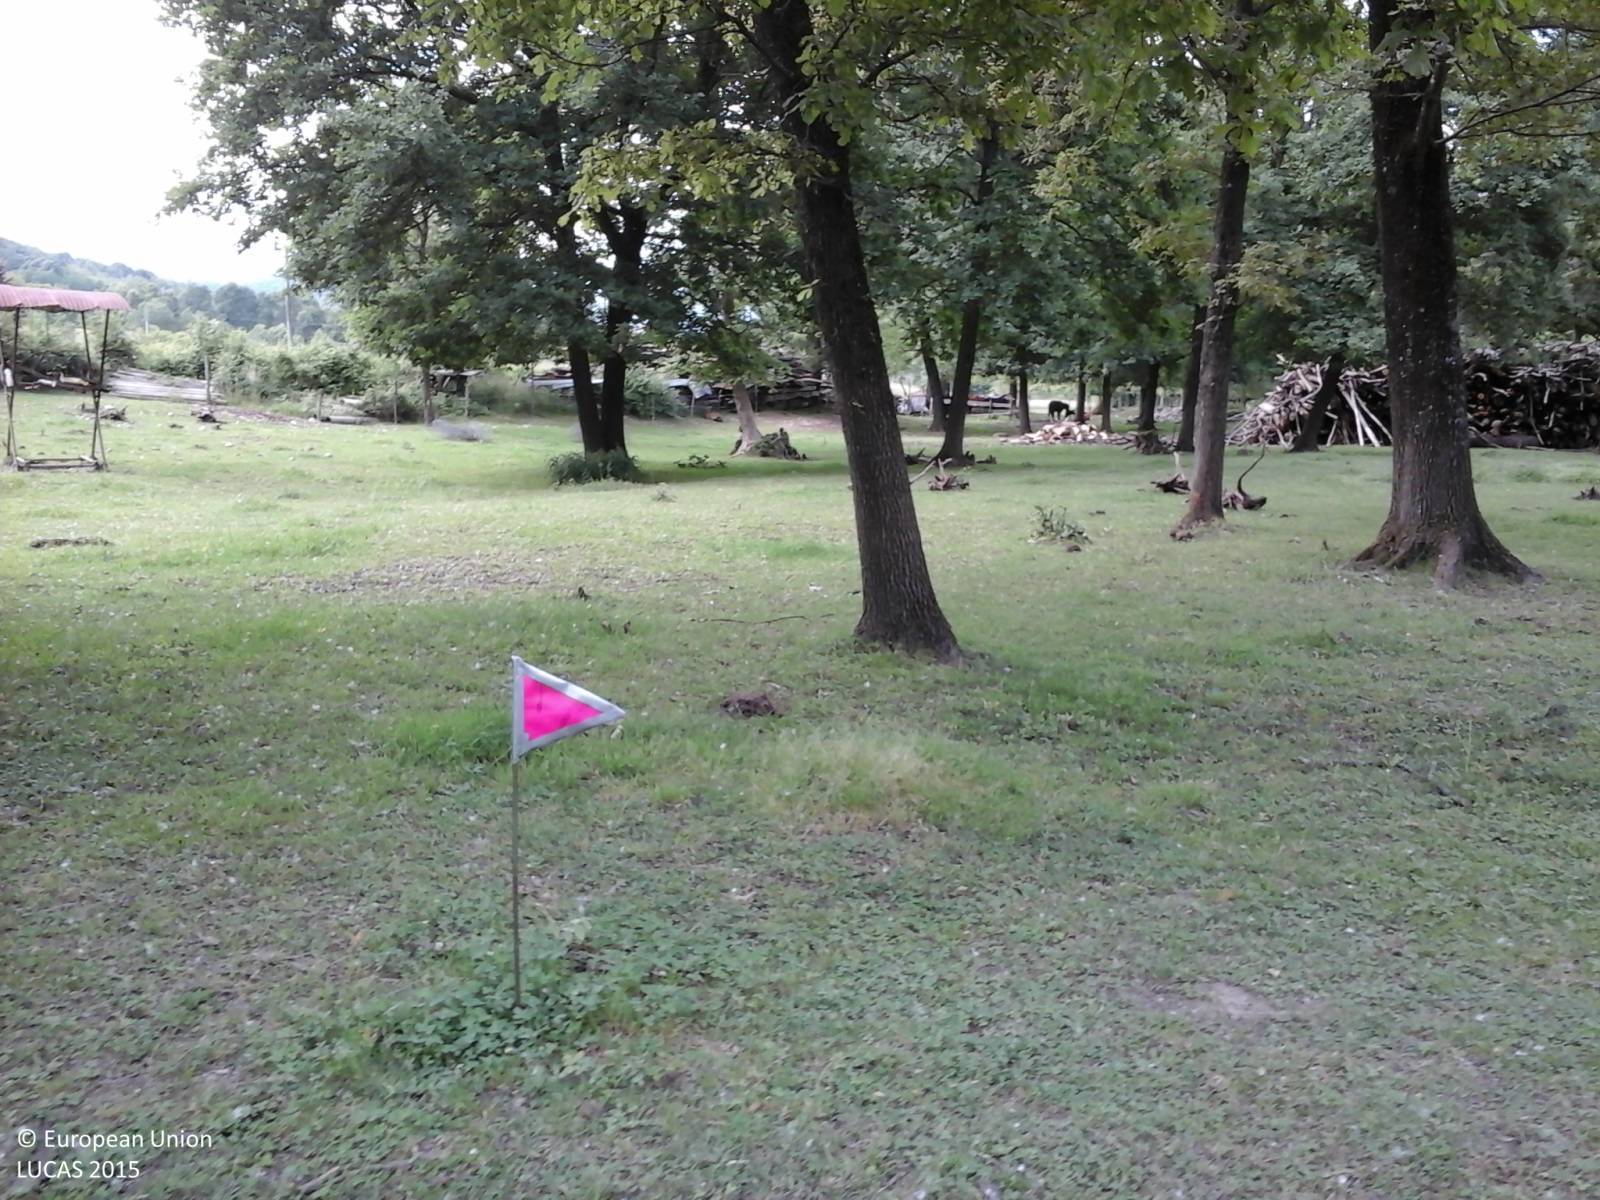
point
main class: Woodland
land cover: Broadleaved woodland
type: mesophytic deciduous forest
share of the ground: 50 - 75 %
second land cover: Grassland without tree/shrub cover
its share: > 75 %
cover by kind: broadleaved forest trees 60 %, herbaceous plants 40 %
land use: Forestry
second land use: Agriculture (excluding fallow land and kitchen gardens)
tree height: > 5 m
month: May
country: IT
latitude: 46.1561
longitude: 13.2985
